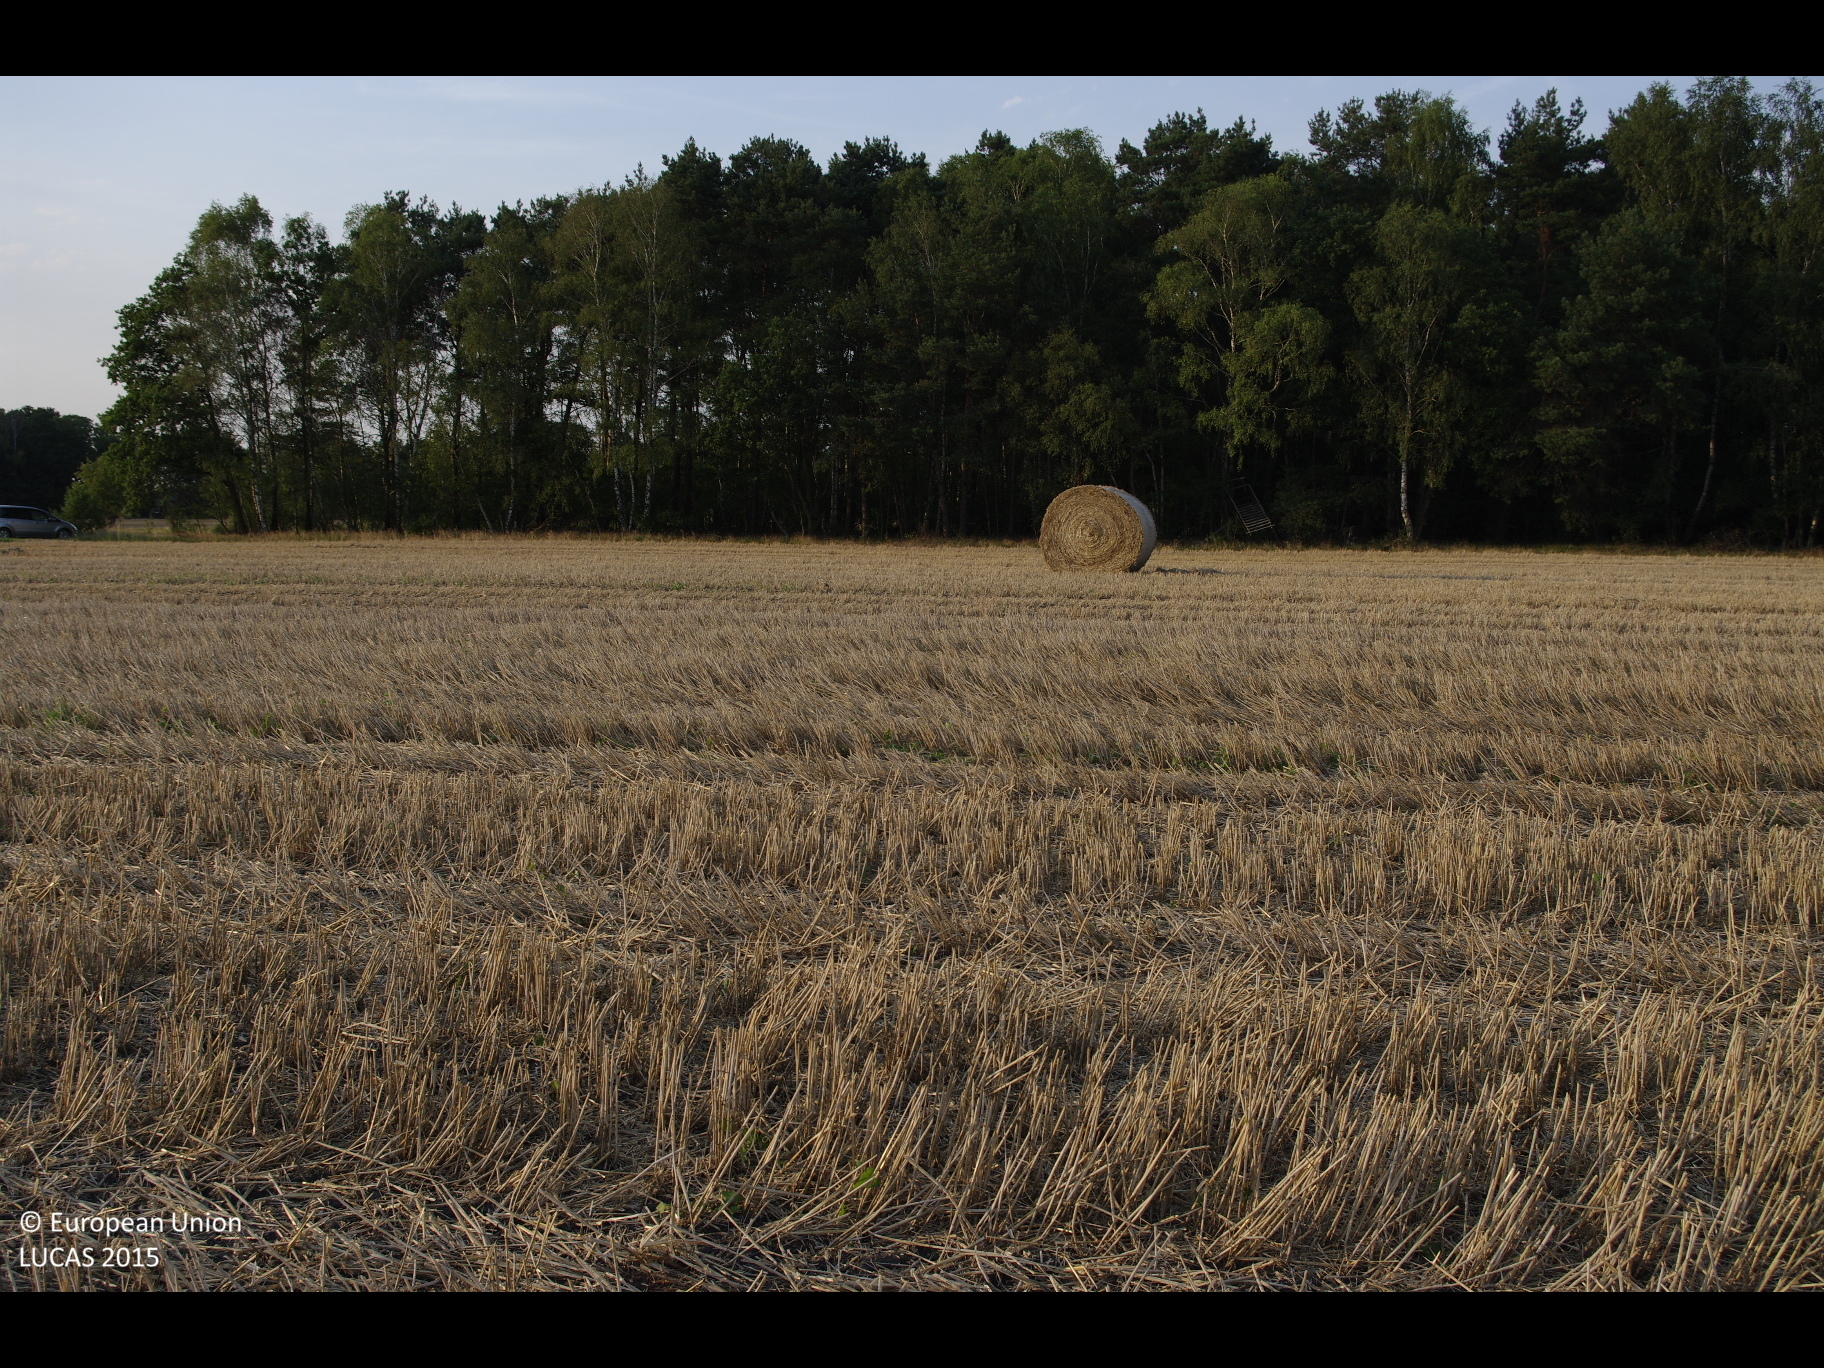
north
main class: Cropland
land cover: Rye
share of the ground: 50 - 75 %
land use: Agriculture (excluding fallow land and kitchen gardens)
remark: Harvested field
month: August
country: DE
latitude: 53.1682
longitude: 9.8355
